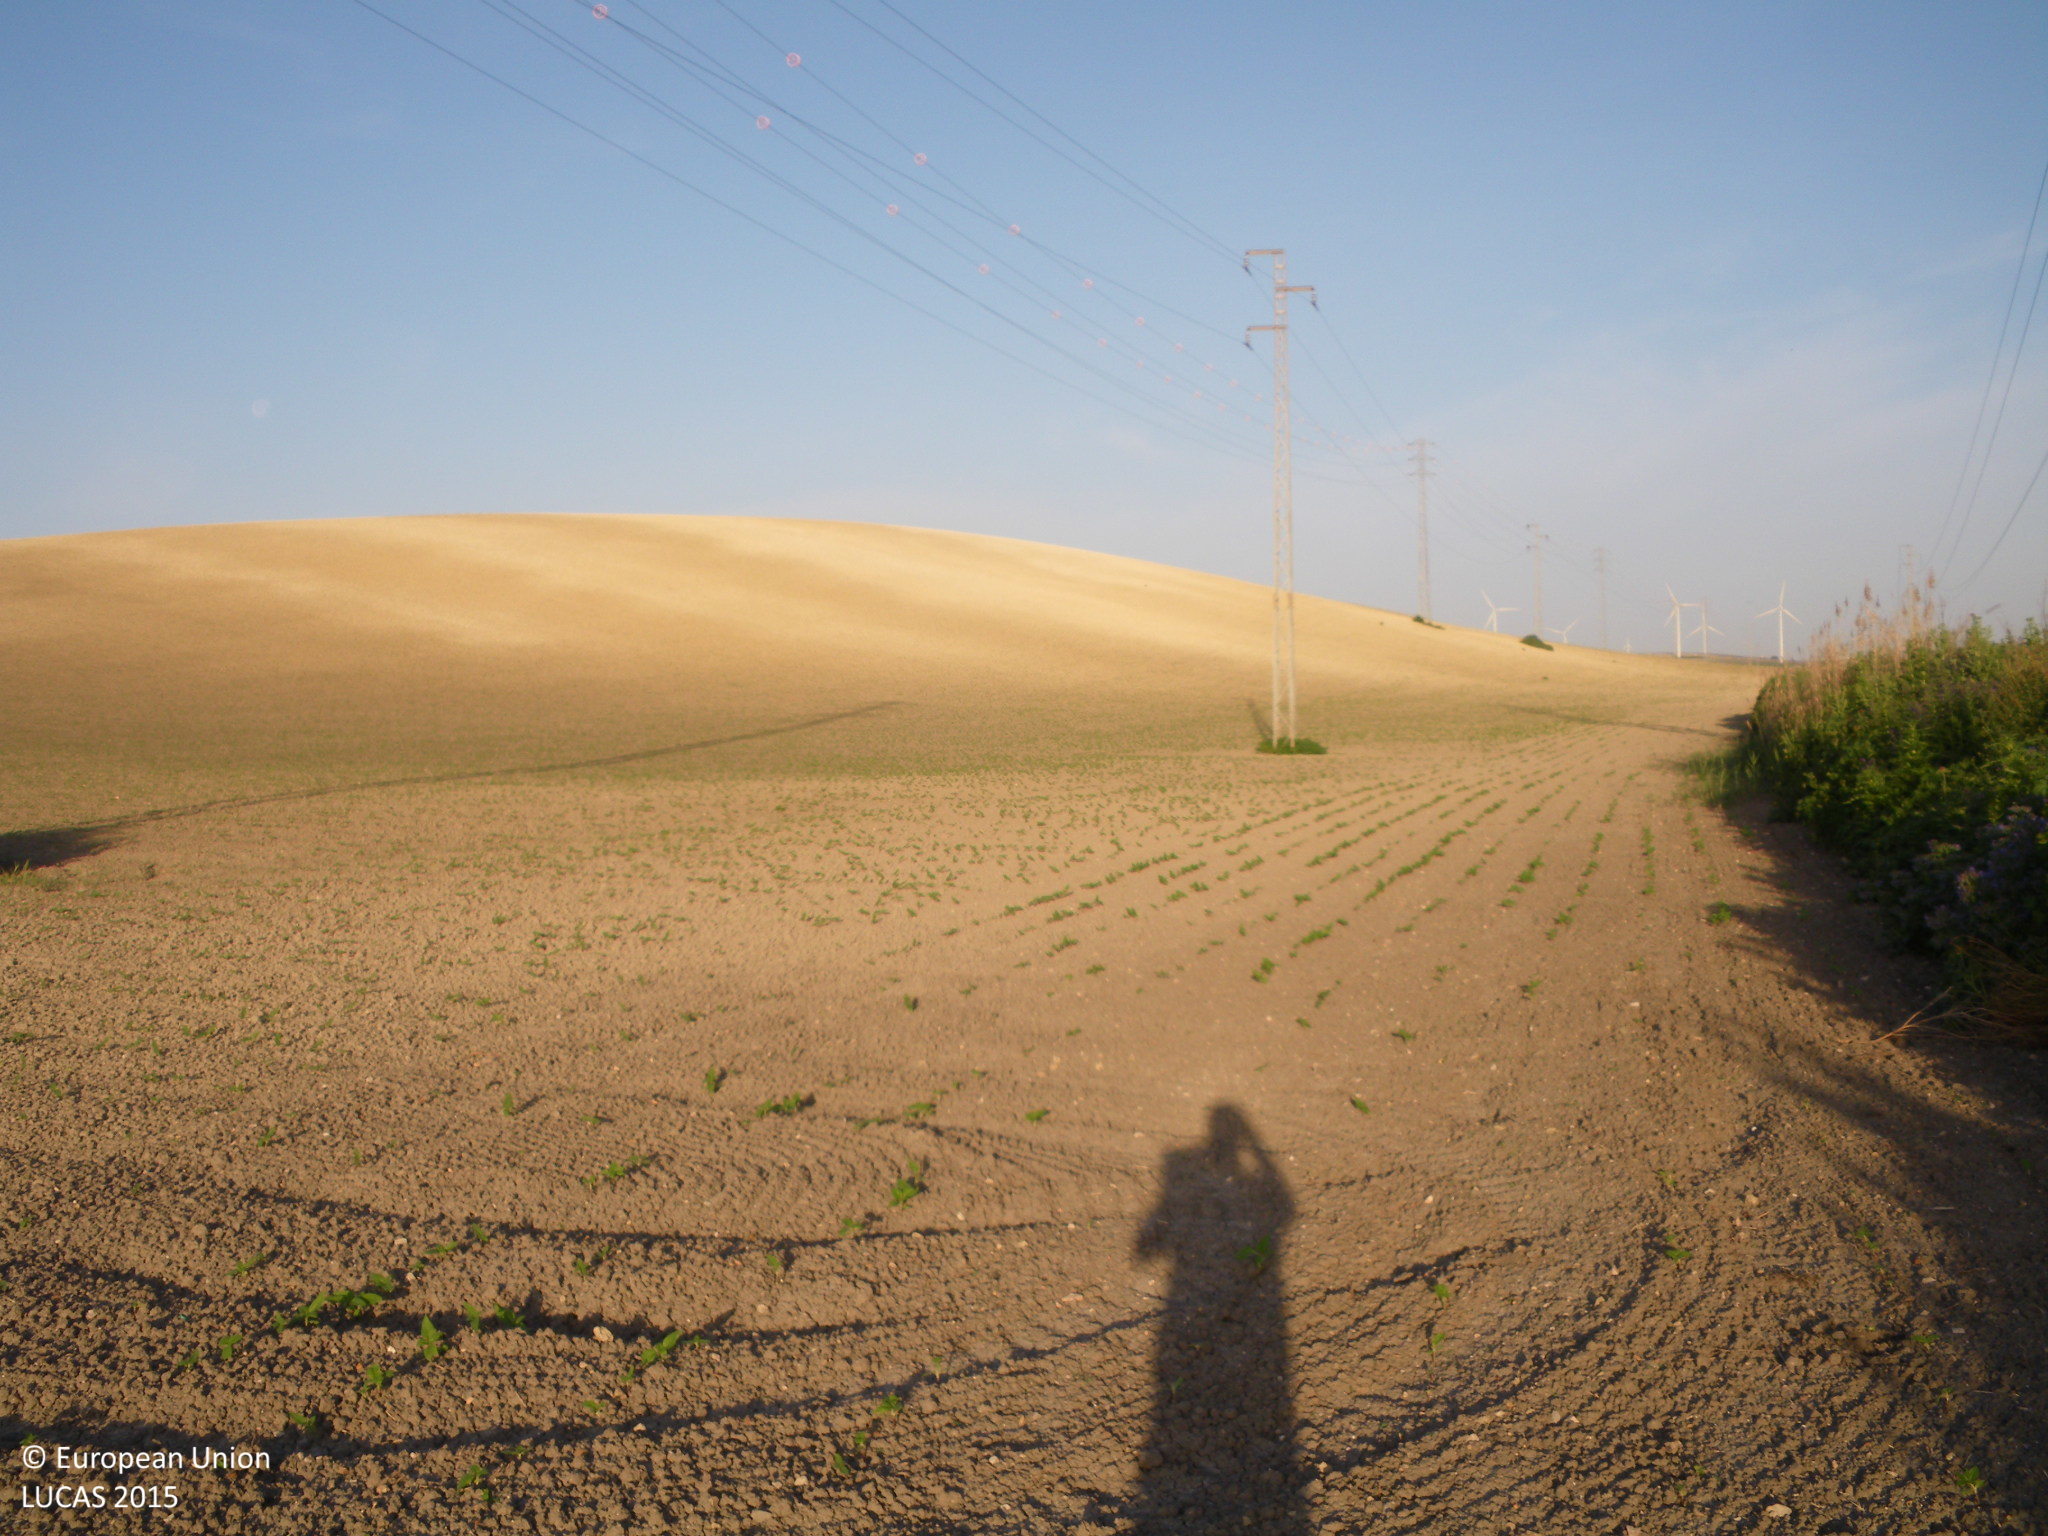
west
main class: Cropland
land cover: Sunflower
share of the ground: < 10 %
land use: Agriculture (excluding fallow land and kitchen gardens)
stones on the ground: < 10 %
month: April
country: ES
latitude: 36.6835
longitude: -6.1837
